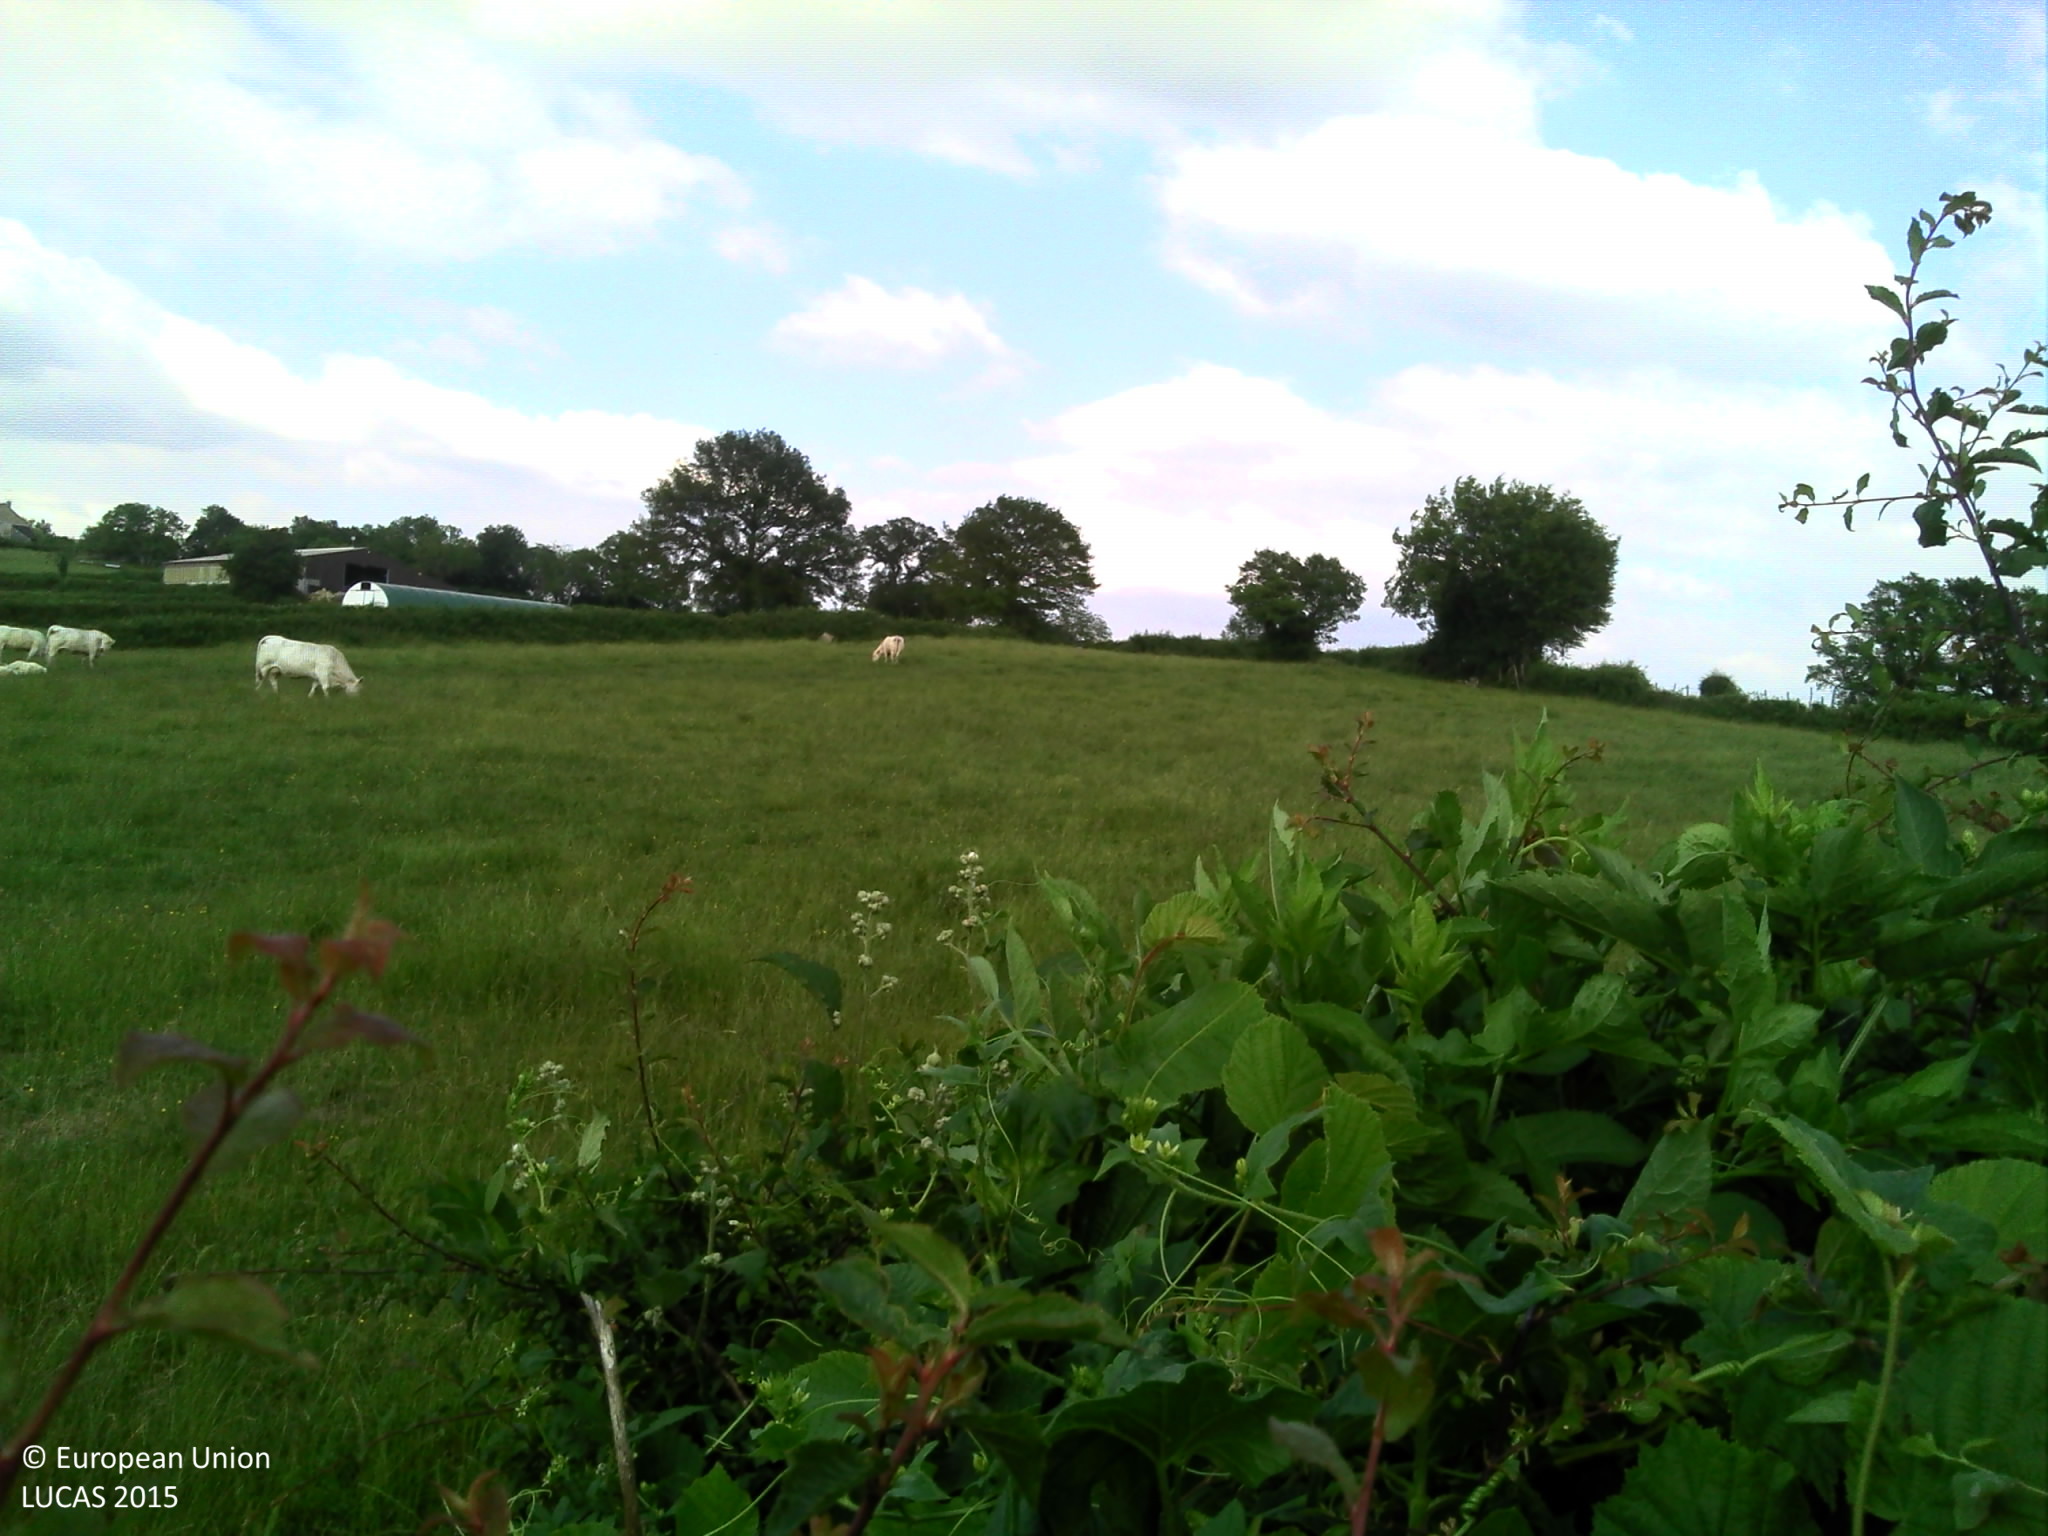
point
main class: Grassland
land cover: Grassland without tree/shrub cover
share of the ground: > 75 %
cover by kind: herbaceous plants 100 %
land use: Agriculture (excluding fallow land and kitchen gardens)
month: June
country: FR
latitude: 47.3908
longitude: 3.9702
